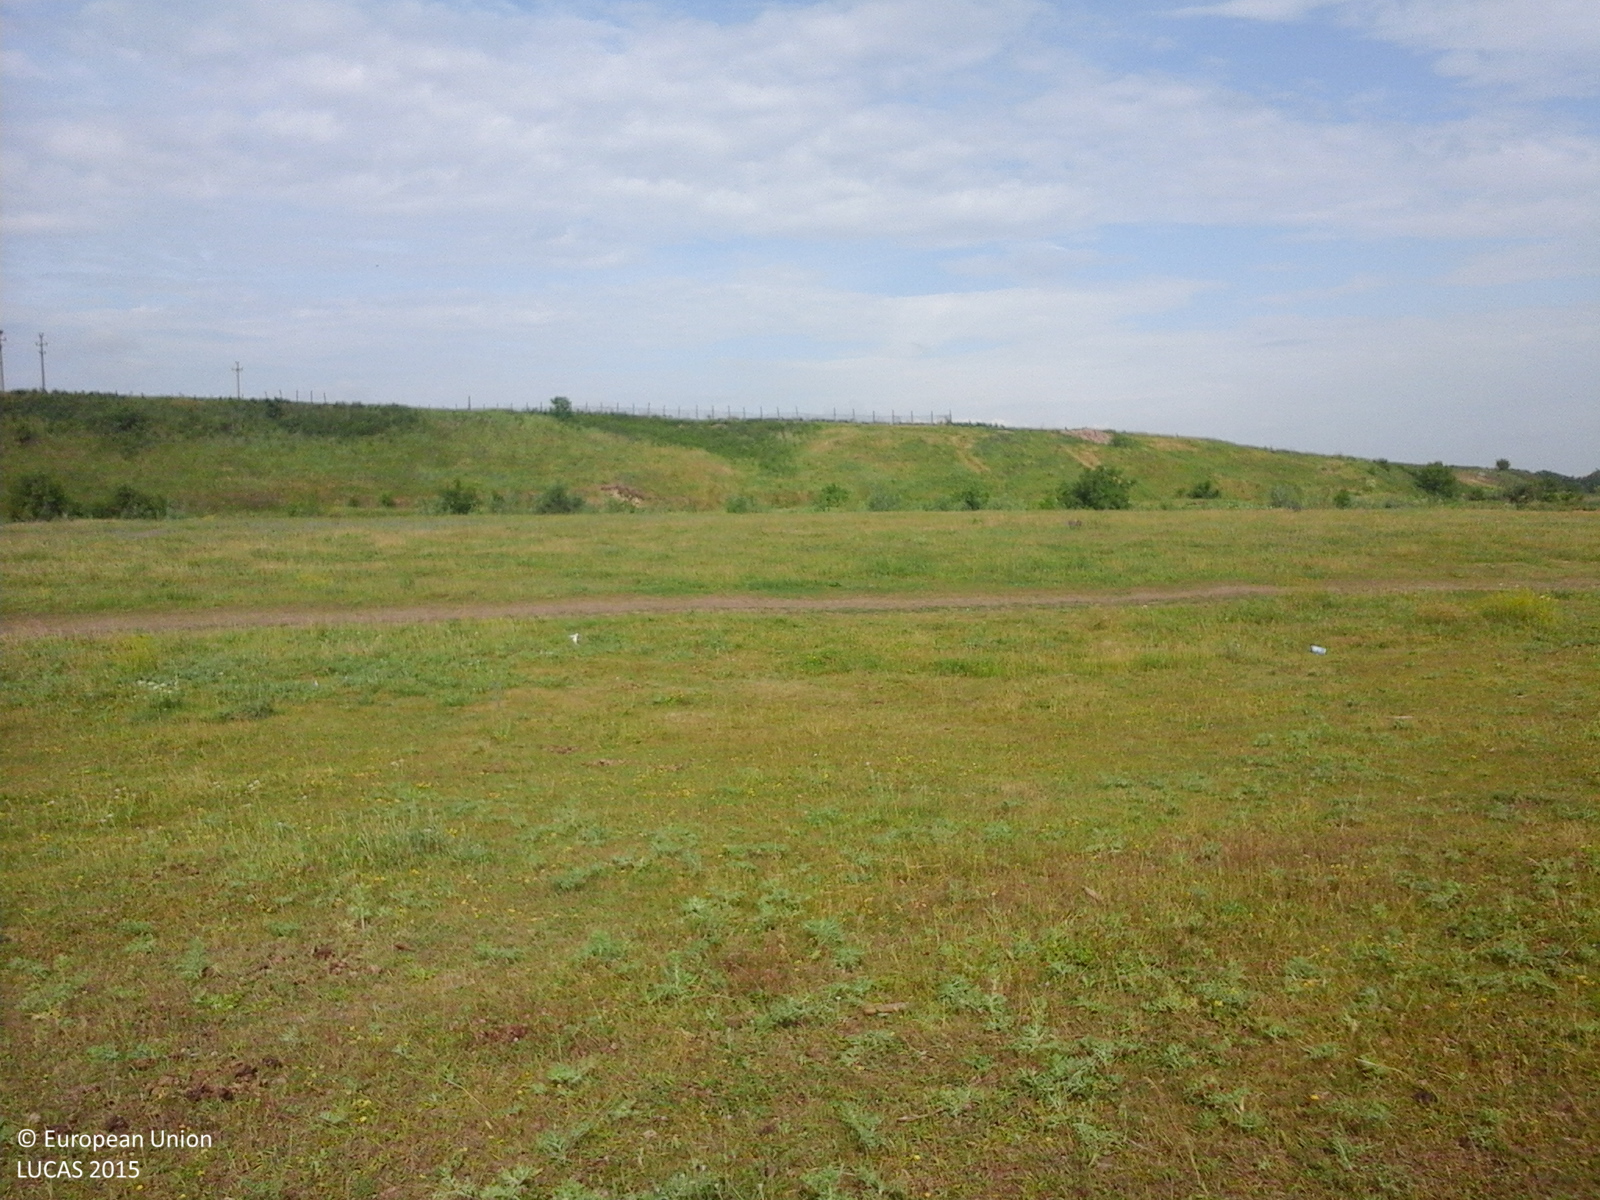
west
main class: Grassland
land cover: Grassland without tree/shrub cover
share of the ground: > 75 %
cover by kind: herbaceous plants 100 %
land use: Agriculture (excluding fallow land and kitchen gardens)
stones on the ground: < 10 %
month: June
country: RO
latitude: 47.0519
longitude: 26.9076
